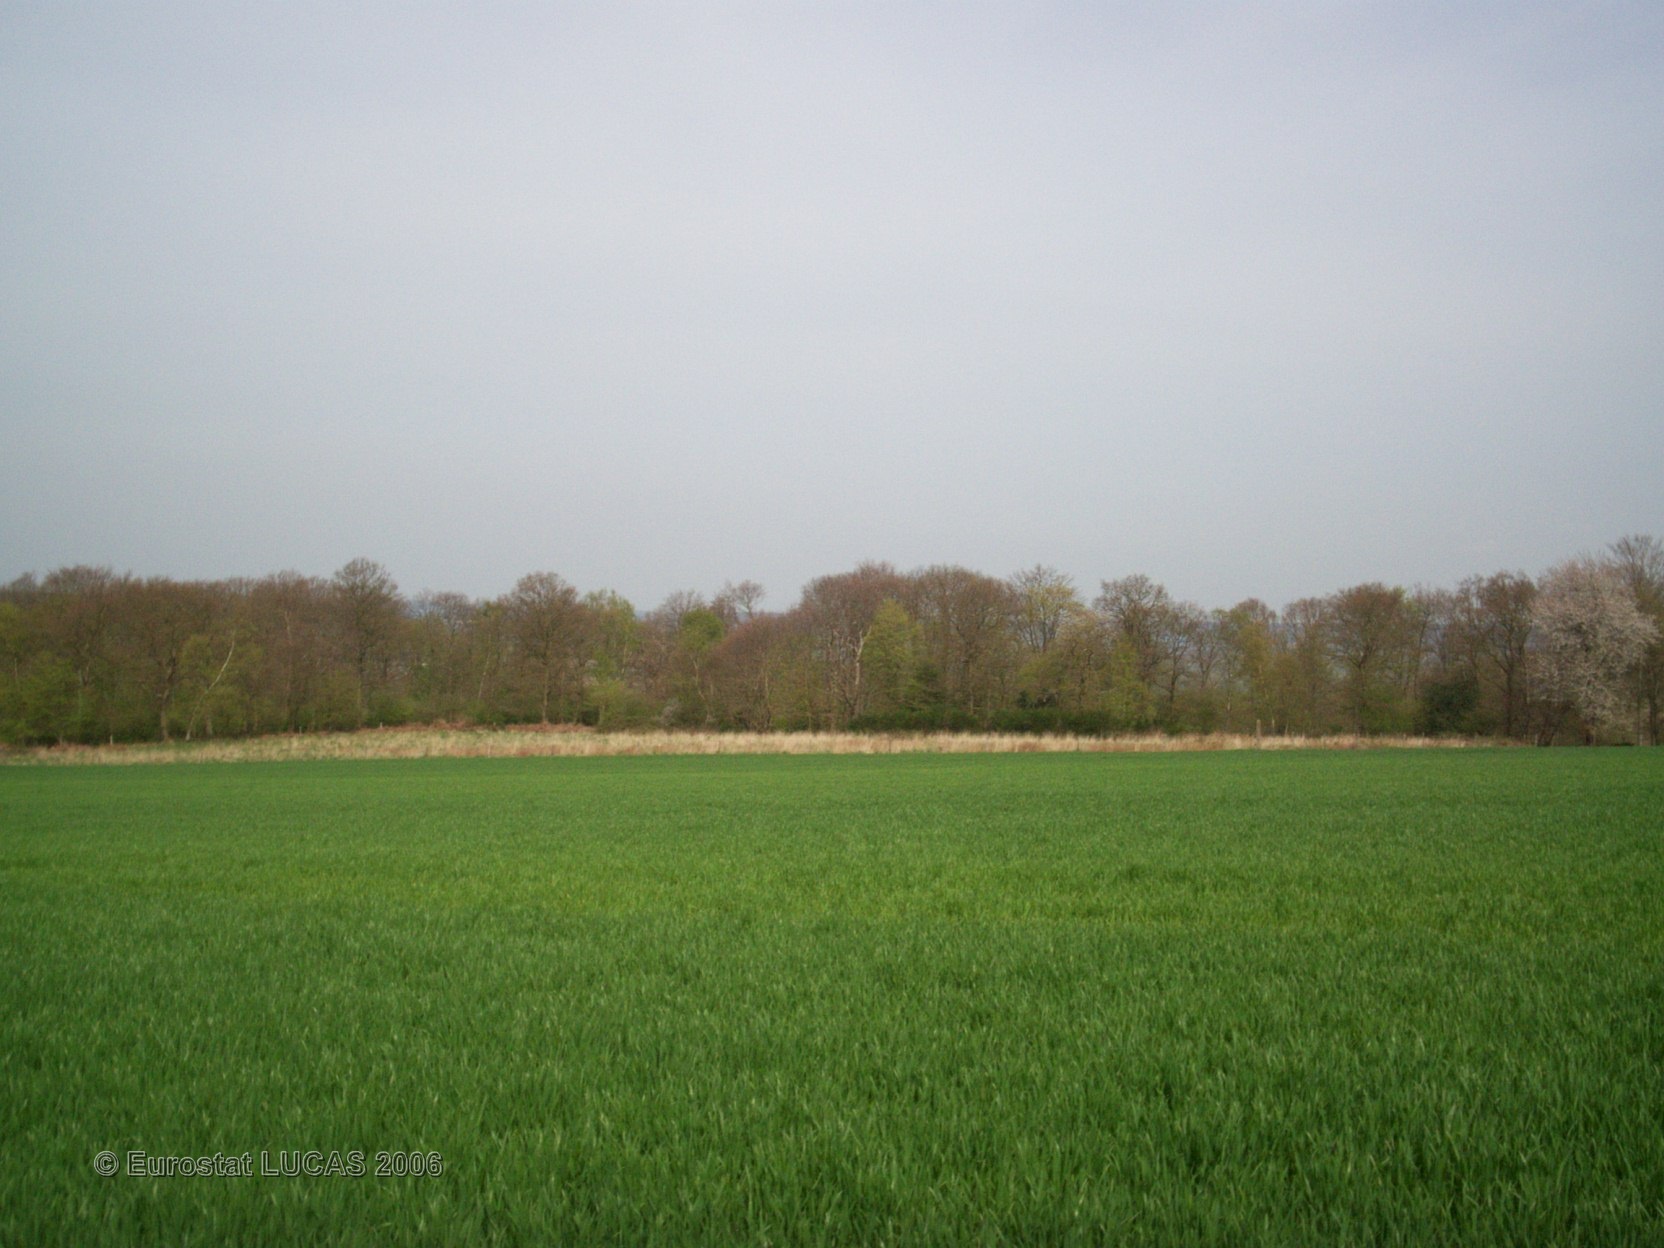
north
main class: Cropland
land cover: Common wheat
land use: Agriculture (excluding fallow land and kitchen gardens)
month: April
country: FR
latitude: 49.4075
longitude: 0.9502
